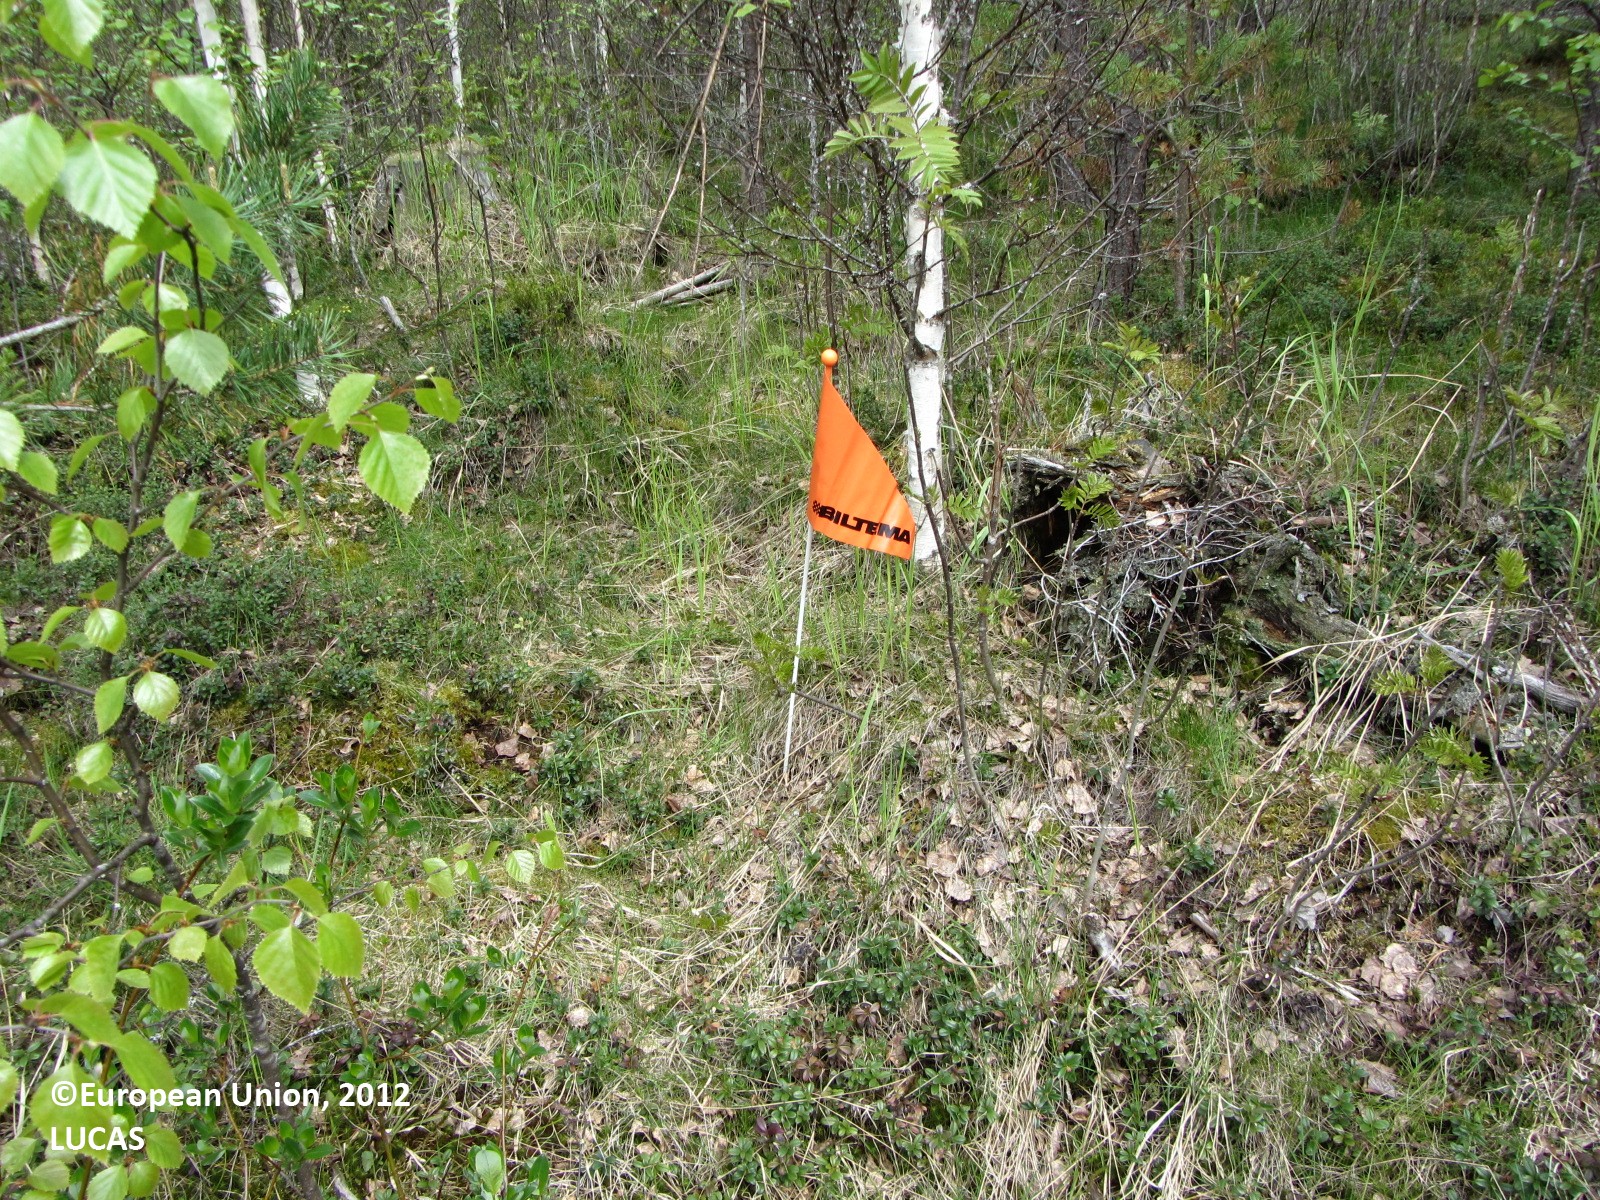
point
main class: Woodland
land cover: Pine dominated mixed woodland
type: boreal forest
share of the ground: > 75 %
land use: Forestry
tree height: < 5 m
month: June
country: FI
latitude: 63.8165
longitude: 24.7266
